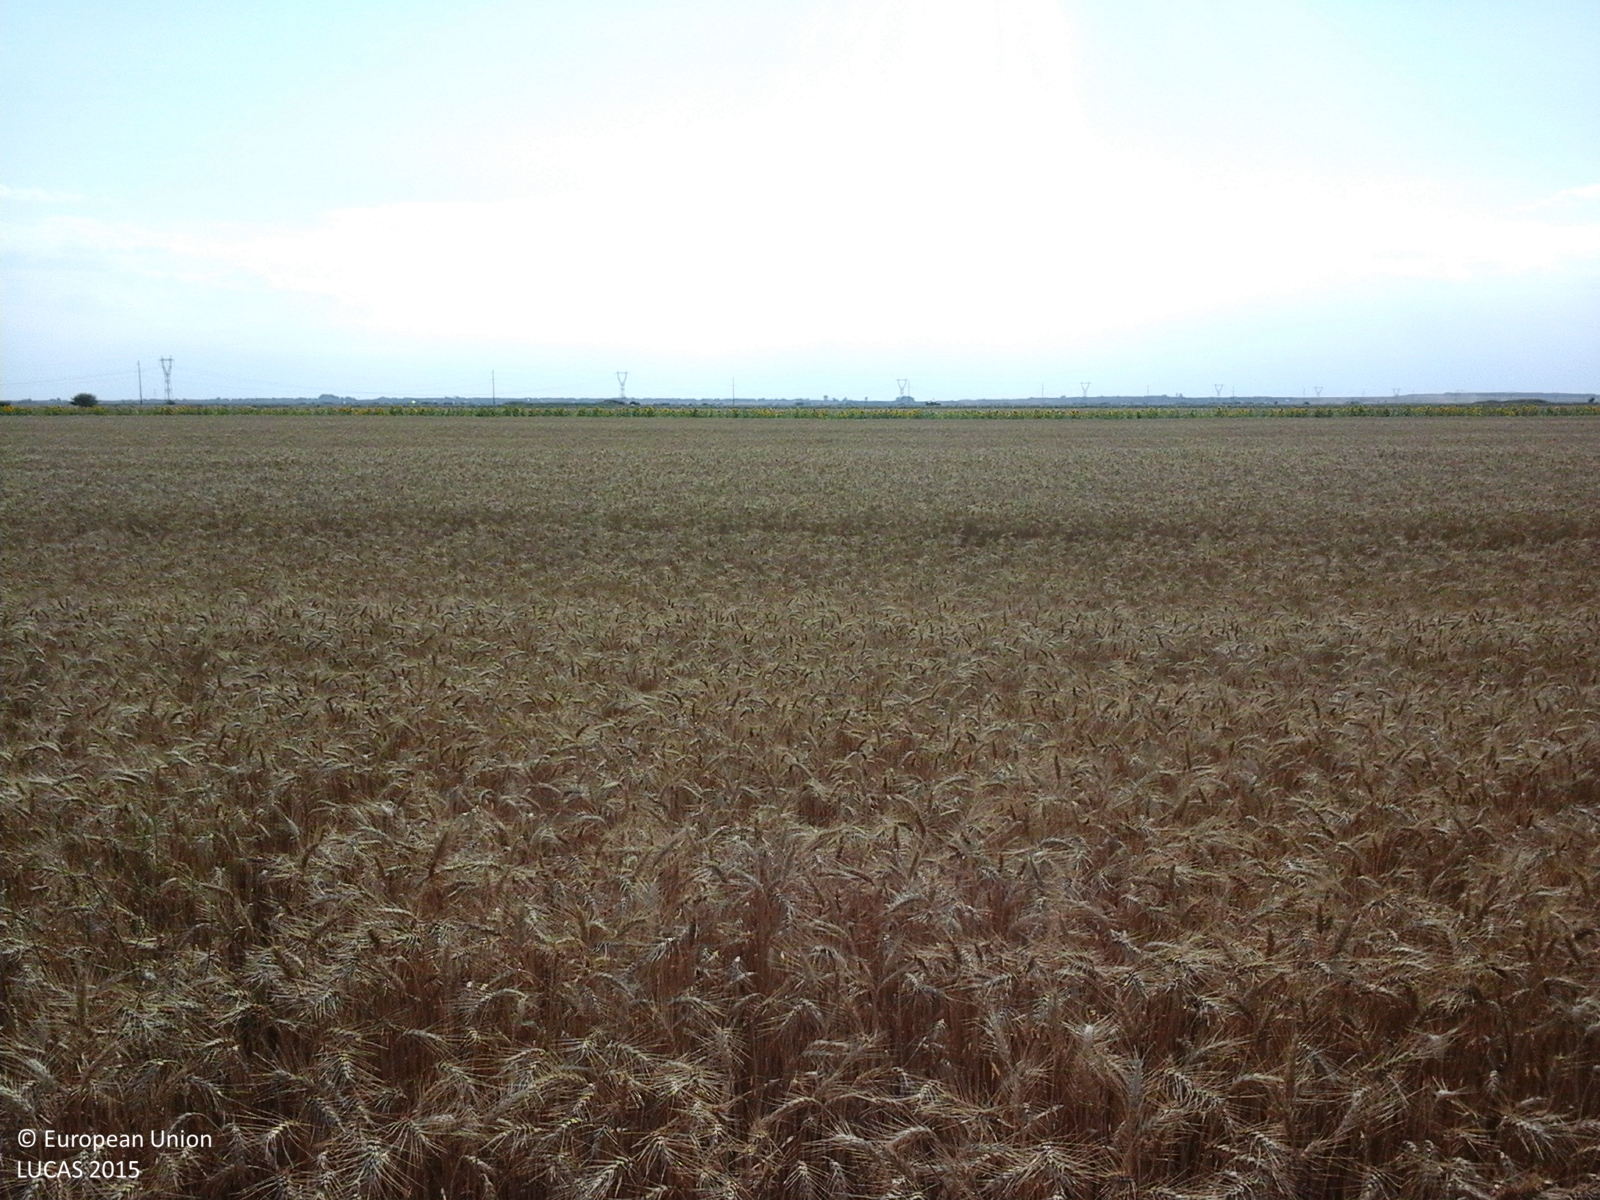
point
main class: Cropland
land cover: Common wheat
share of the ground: > 75 %
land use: Agriculture (excluding fallow land and kitchen gardens)
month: July
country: RO
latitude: 43.9152
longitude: 24.4735
